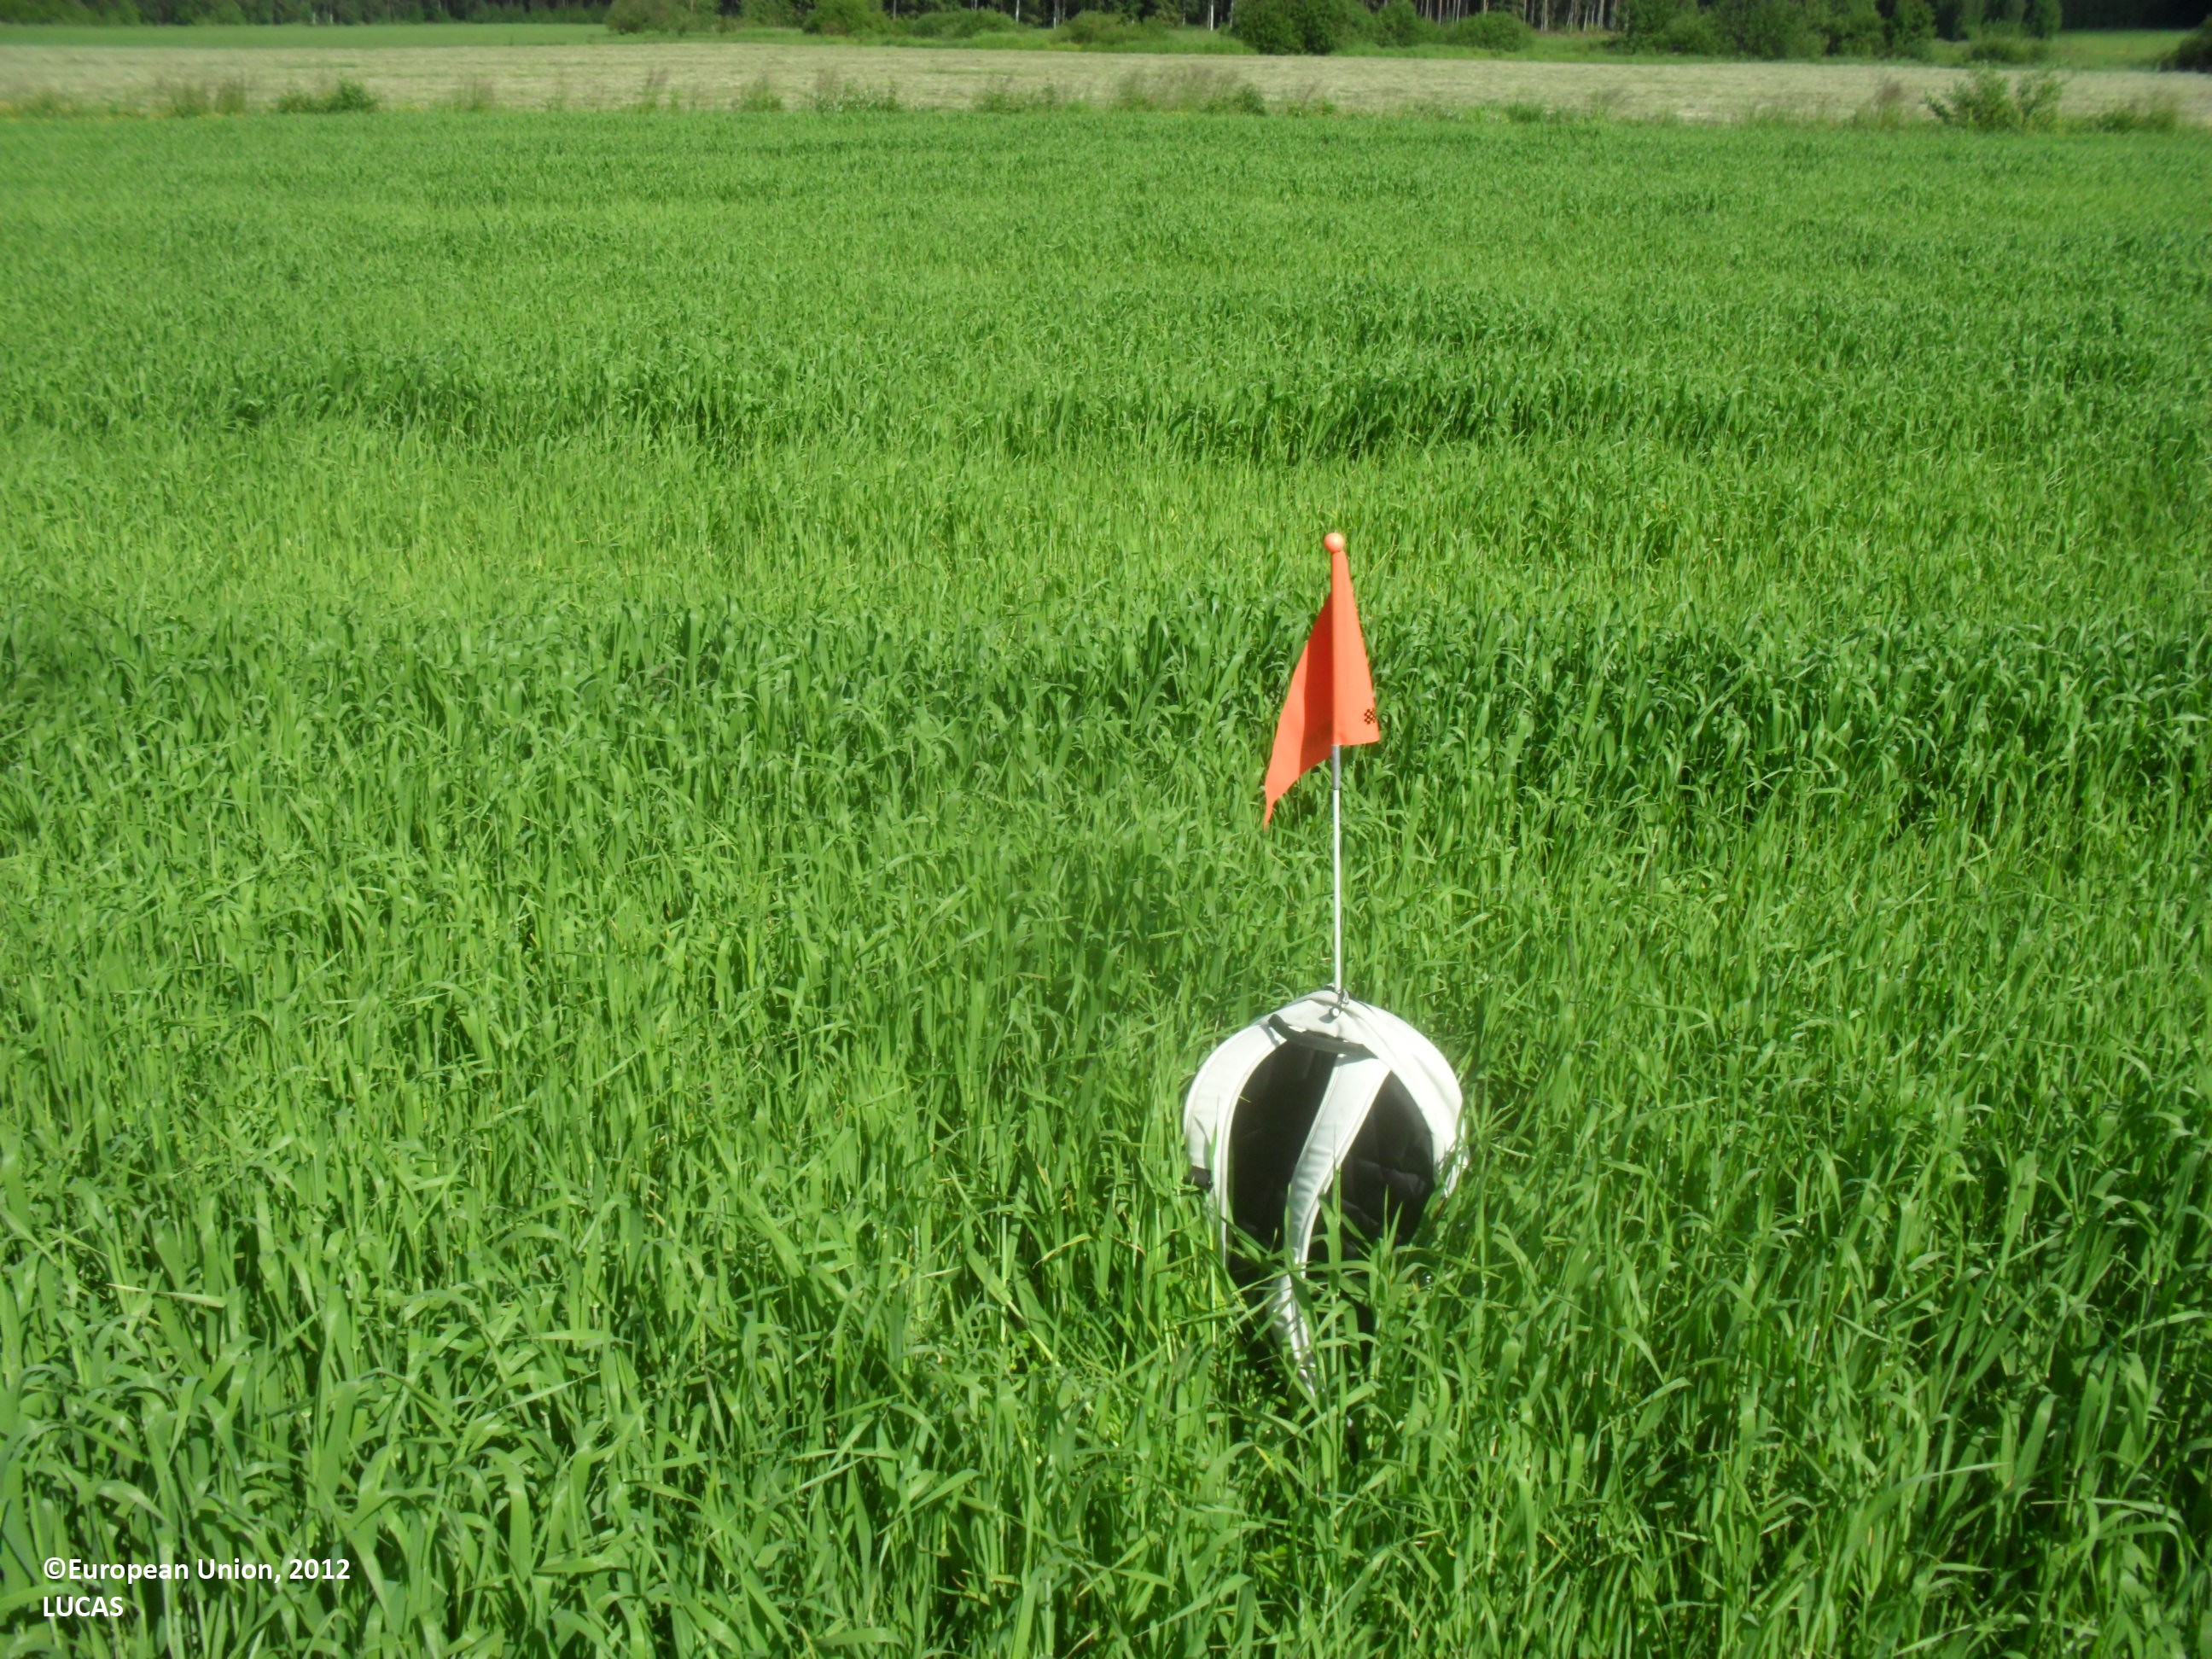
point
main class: Cropland
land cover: Oats
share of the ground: > 75 %
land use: Agriculture (excluding fallow land and kitchen gardens)
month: July
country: FI
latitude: 63.3047
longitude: 23.8972
